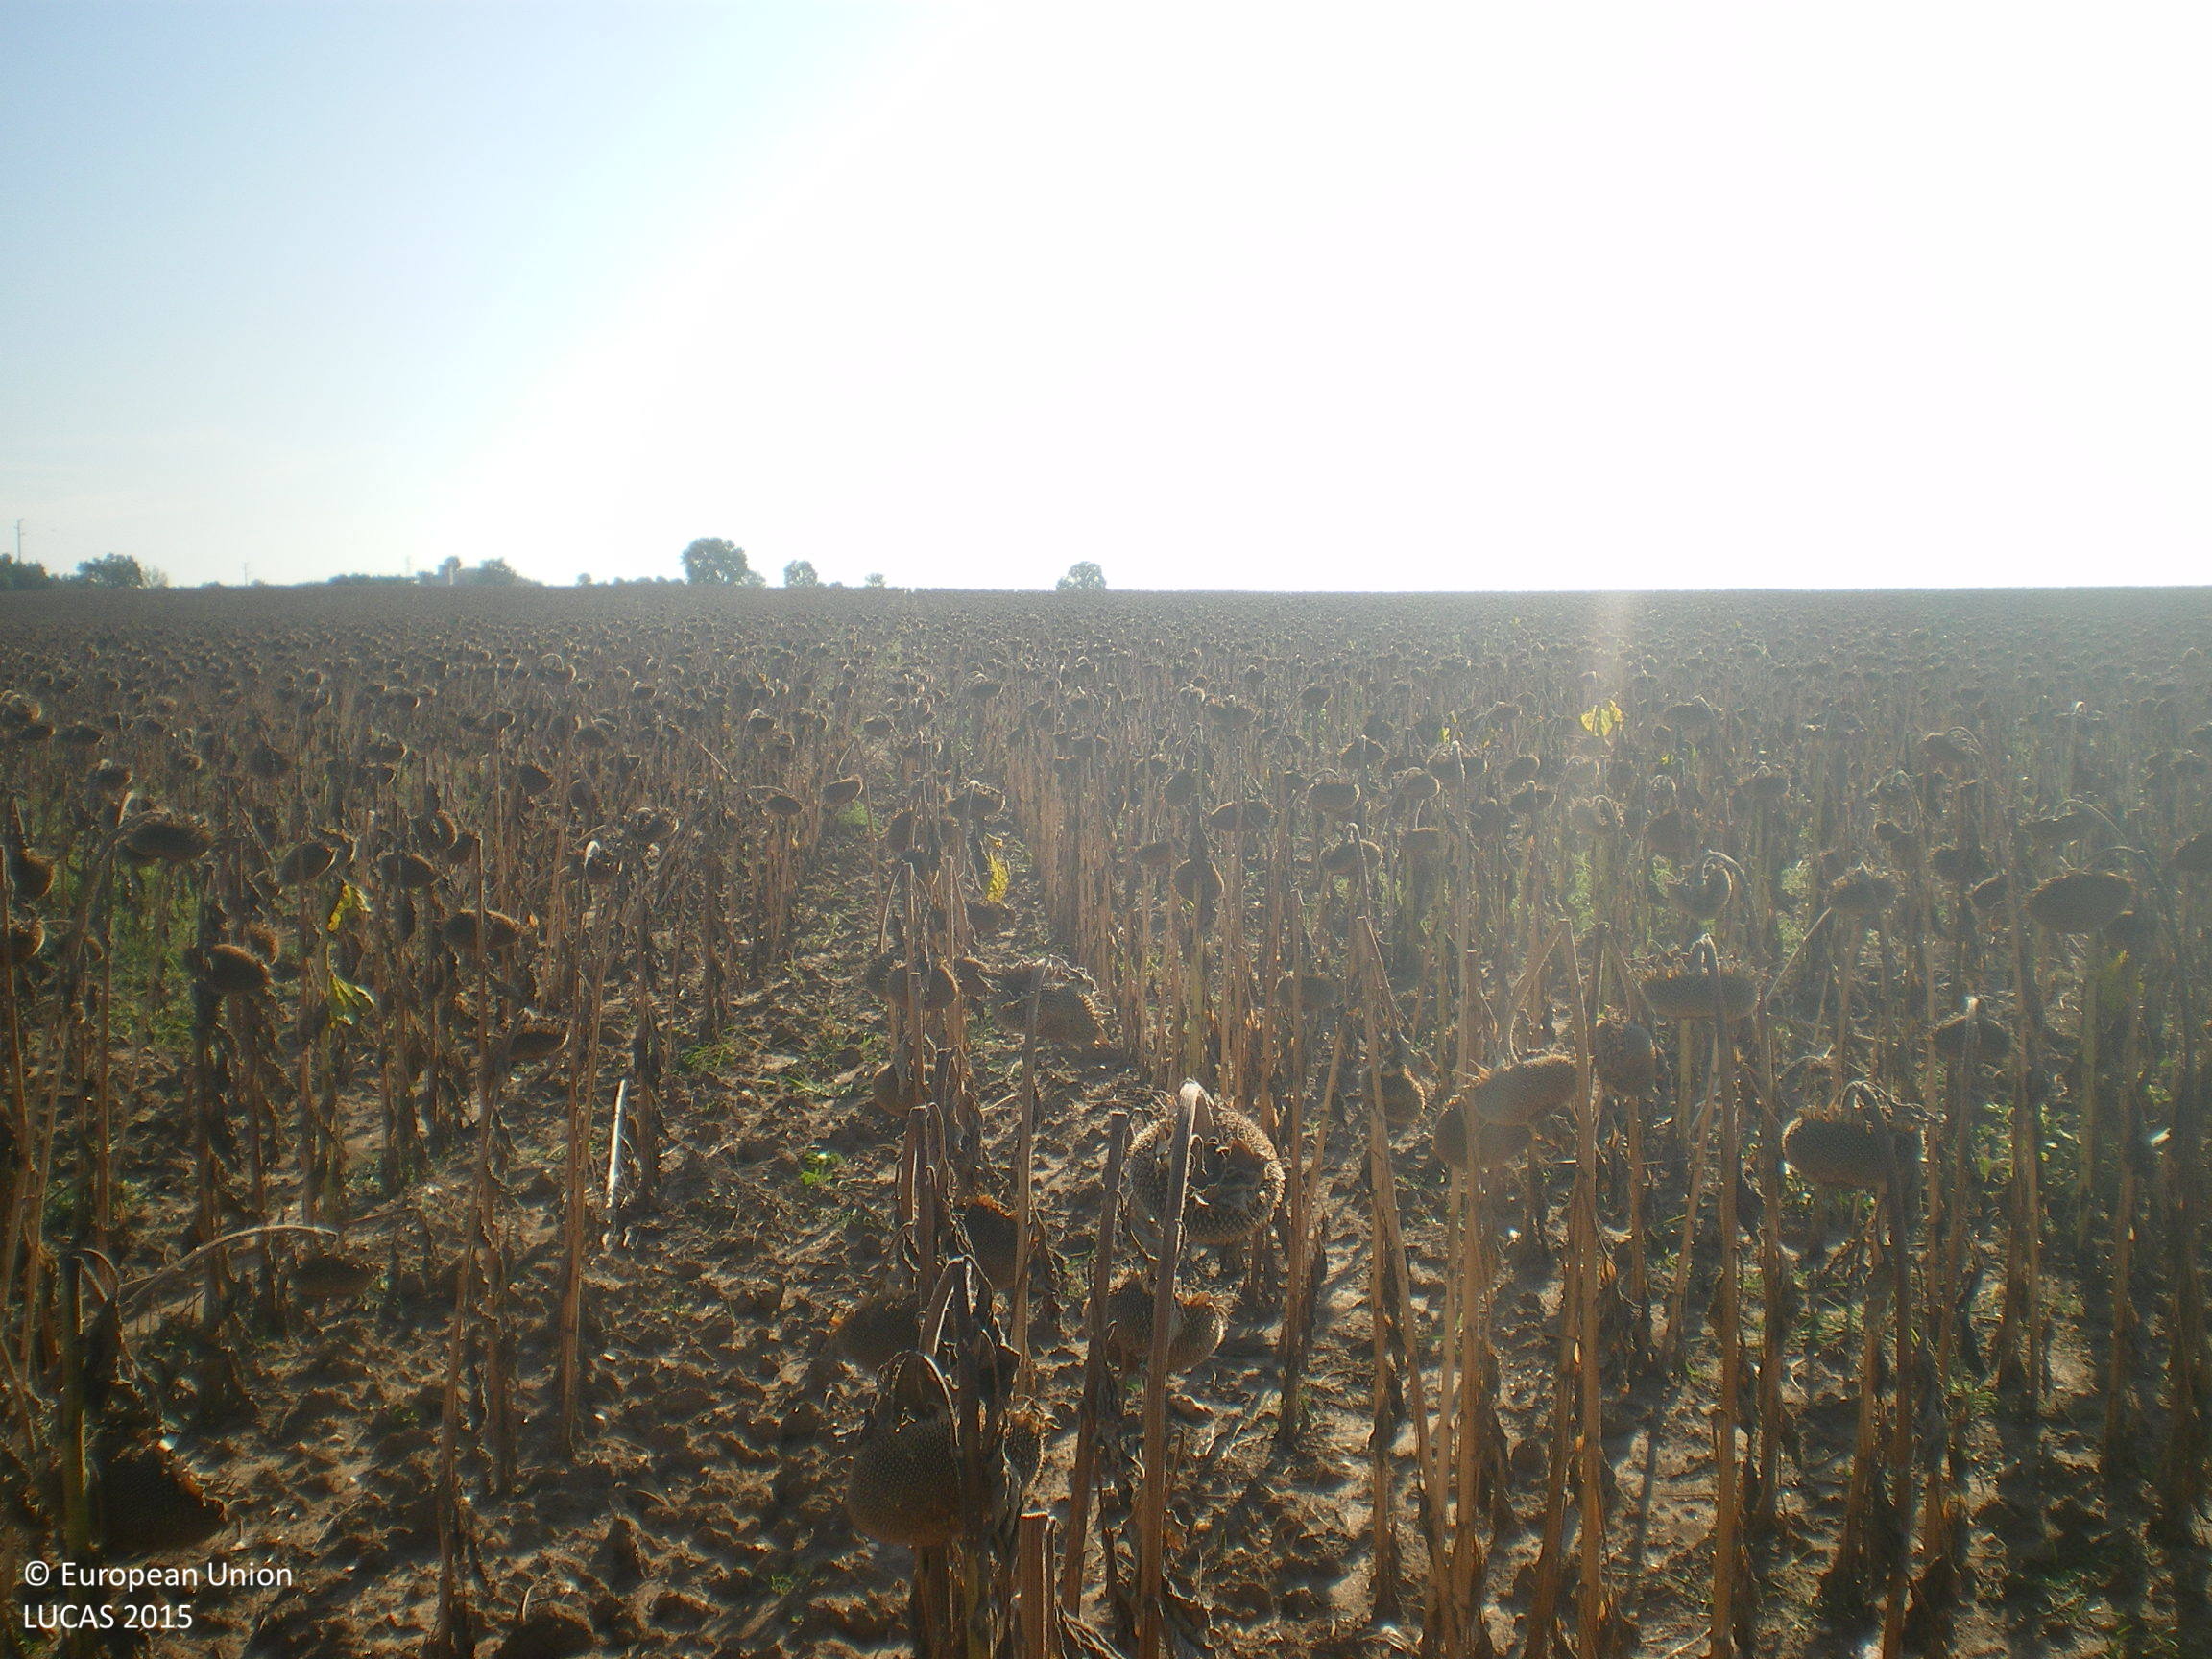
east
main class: Cropland
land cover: Sunflower
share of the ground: > 75 %
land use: Agriculture (excluding fallow land and kitchen gardens)
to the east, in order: Sunflower
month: September
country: BG
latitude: 41.9837
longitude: 25.6242
